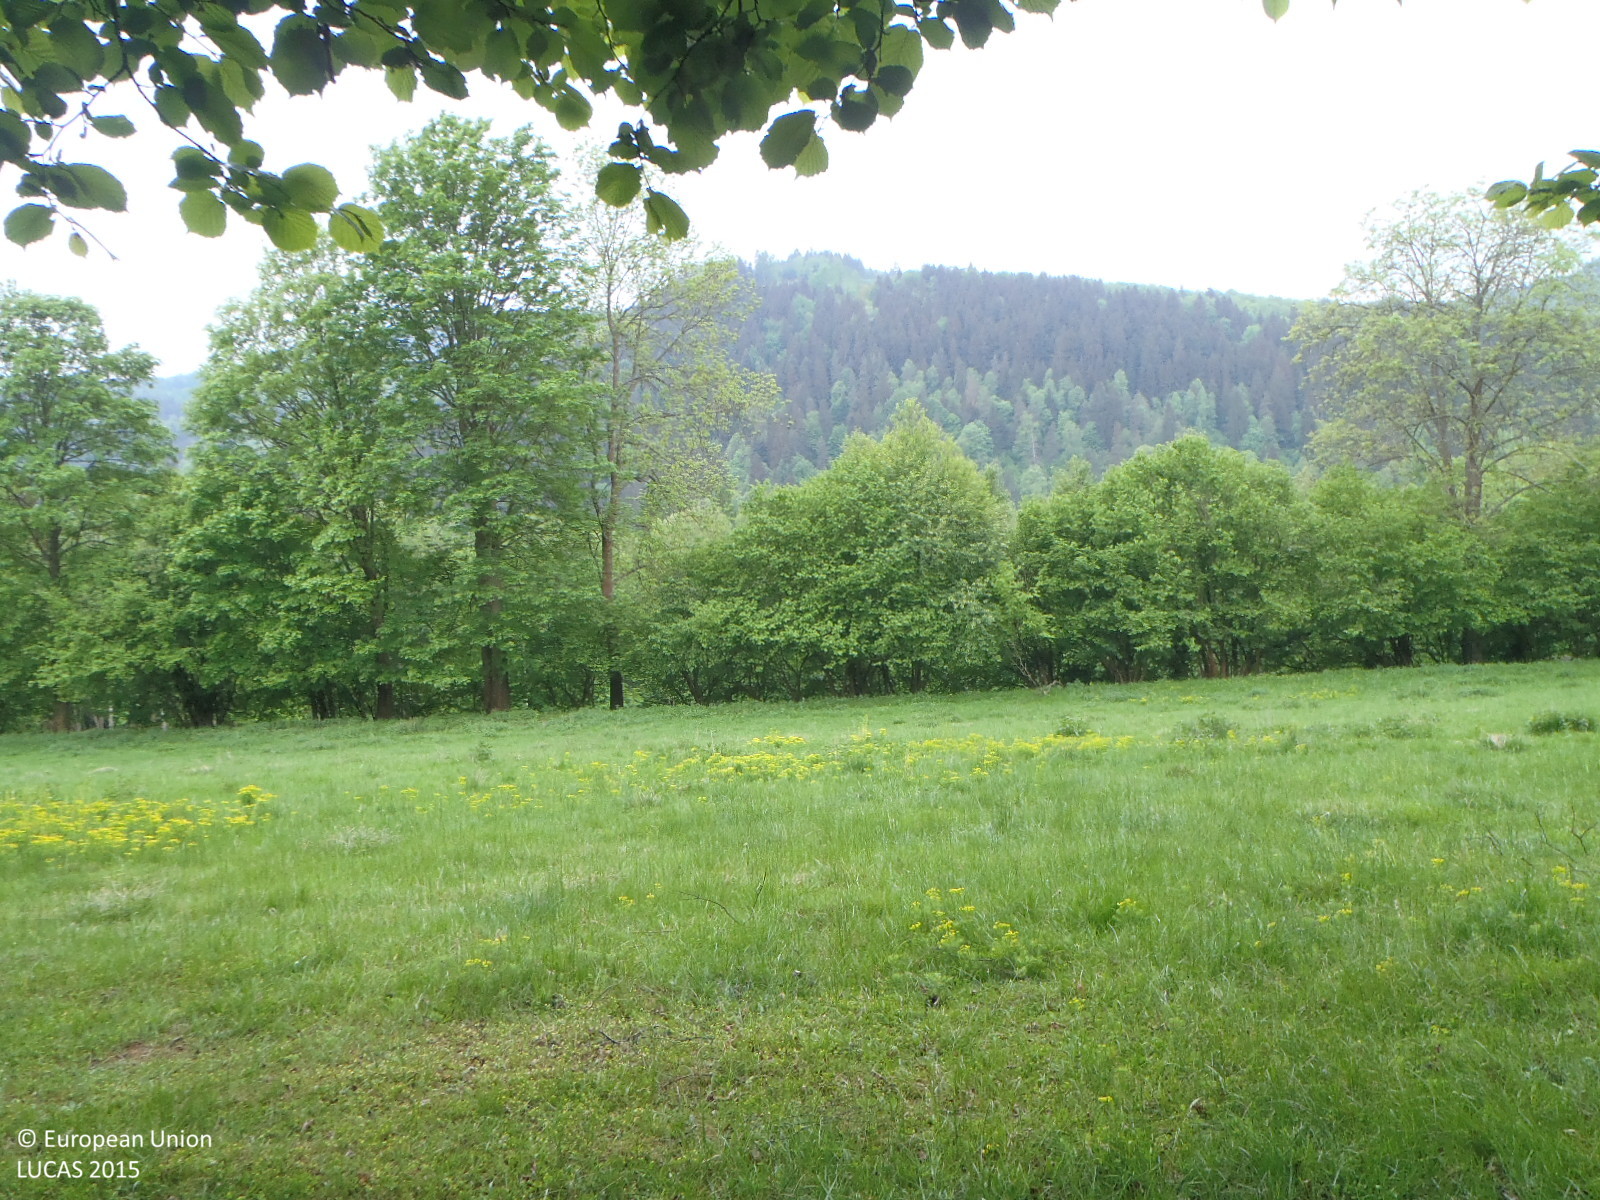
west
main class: Woodland
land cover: Broadleaved woodland
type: mesophytic deciduous forest
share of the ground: > 75 %
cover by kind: broadleaved forest trees 95 %, herbaceous plants 5 %
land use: Agriculture (excluding fallow land and kitchen gardens)
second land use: Forestry
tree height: > 5 m
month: May
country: CZ
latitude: 48.6959
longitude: 14.3618
